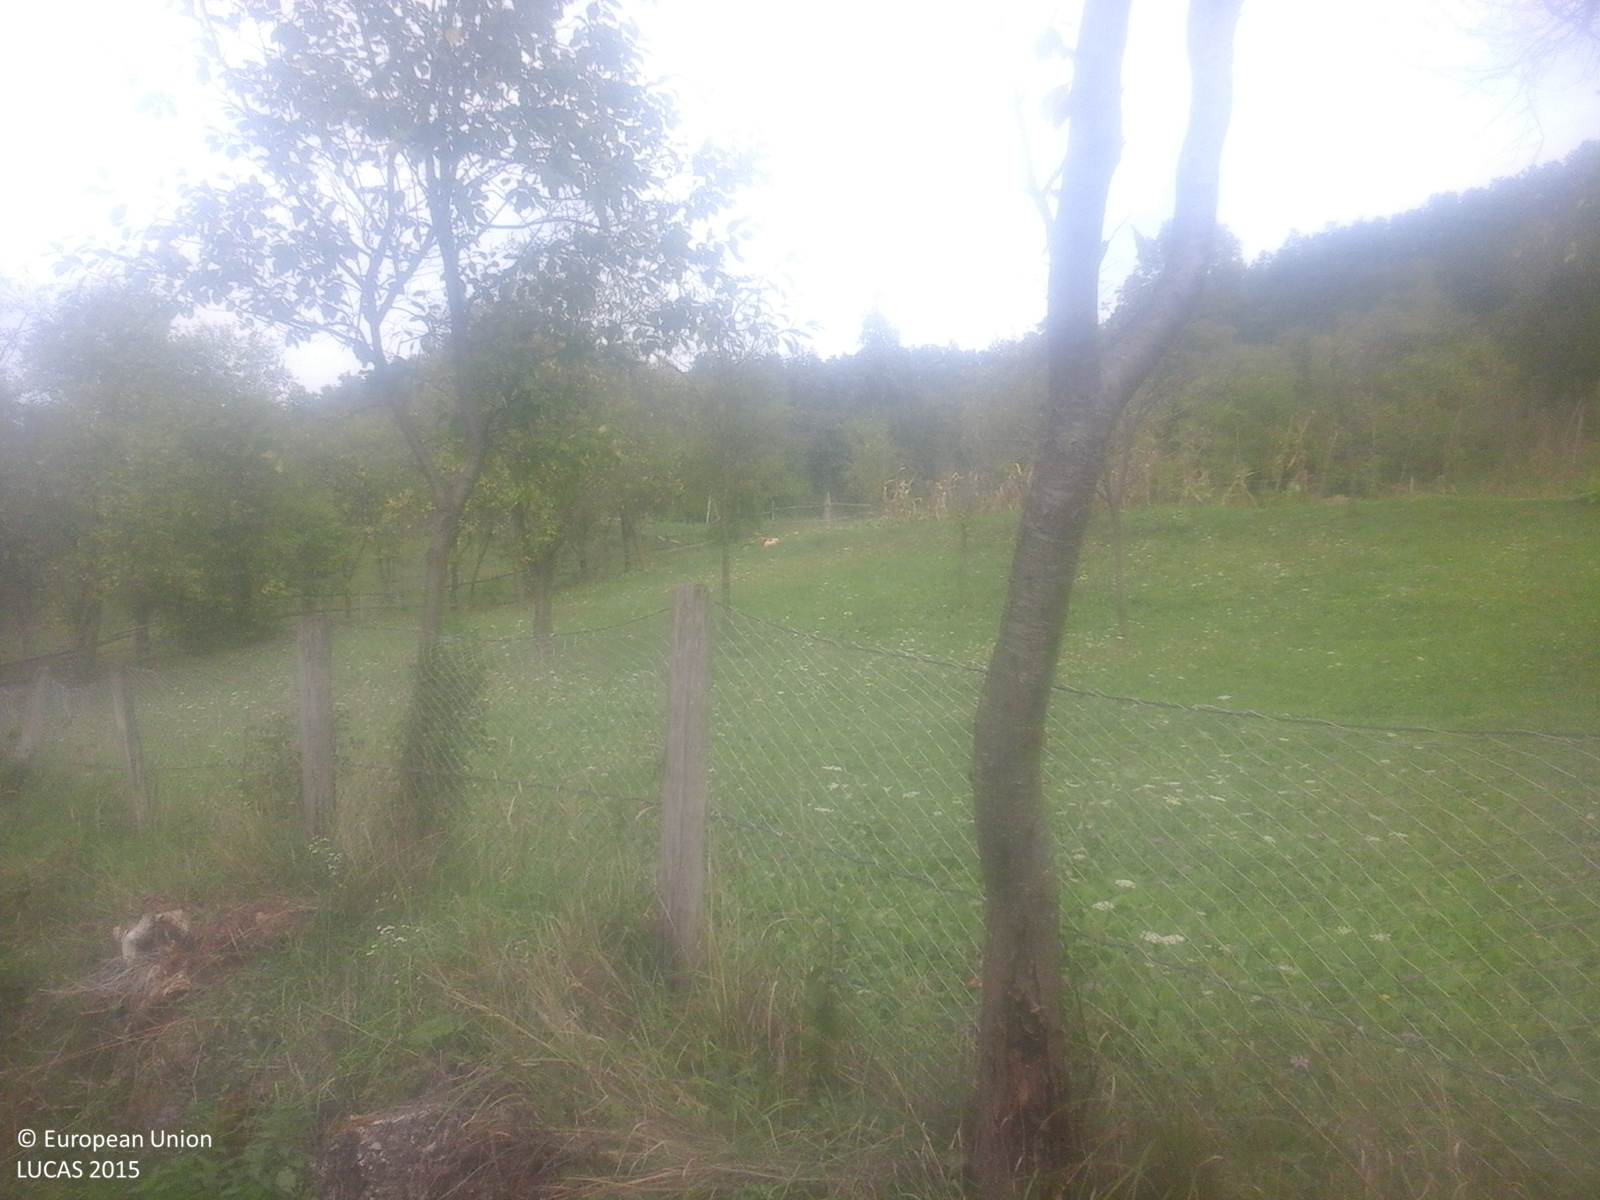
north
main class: Cropland
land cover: Other fruit trees and berries
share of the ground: 50 - 75 %
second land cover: Grassland without tree/shrub cover
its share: > 75 %
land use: Agriculture (excluding fallow land and kitchen gardens)
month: September
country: RO
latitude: 46.0565
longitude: 22.9161
